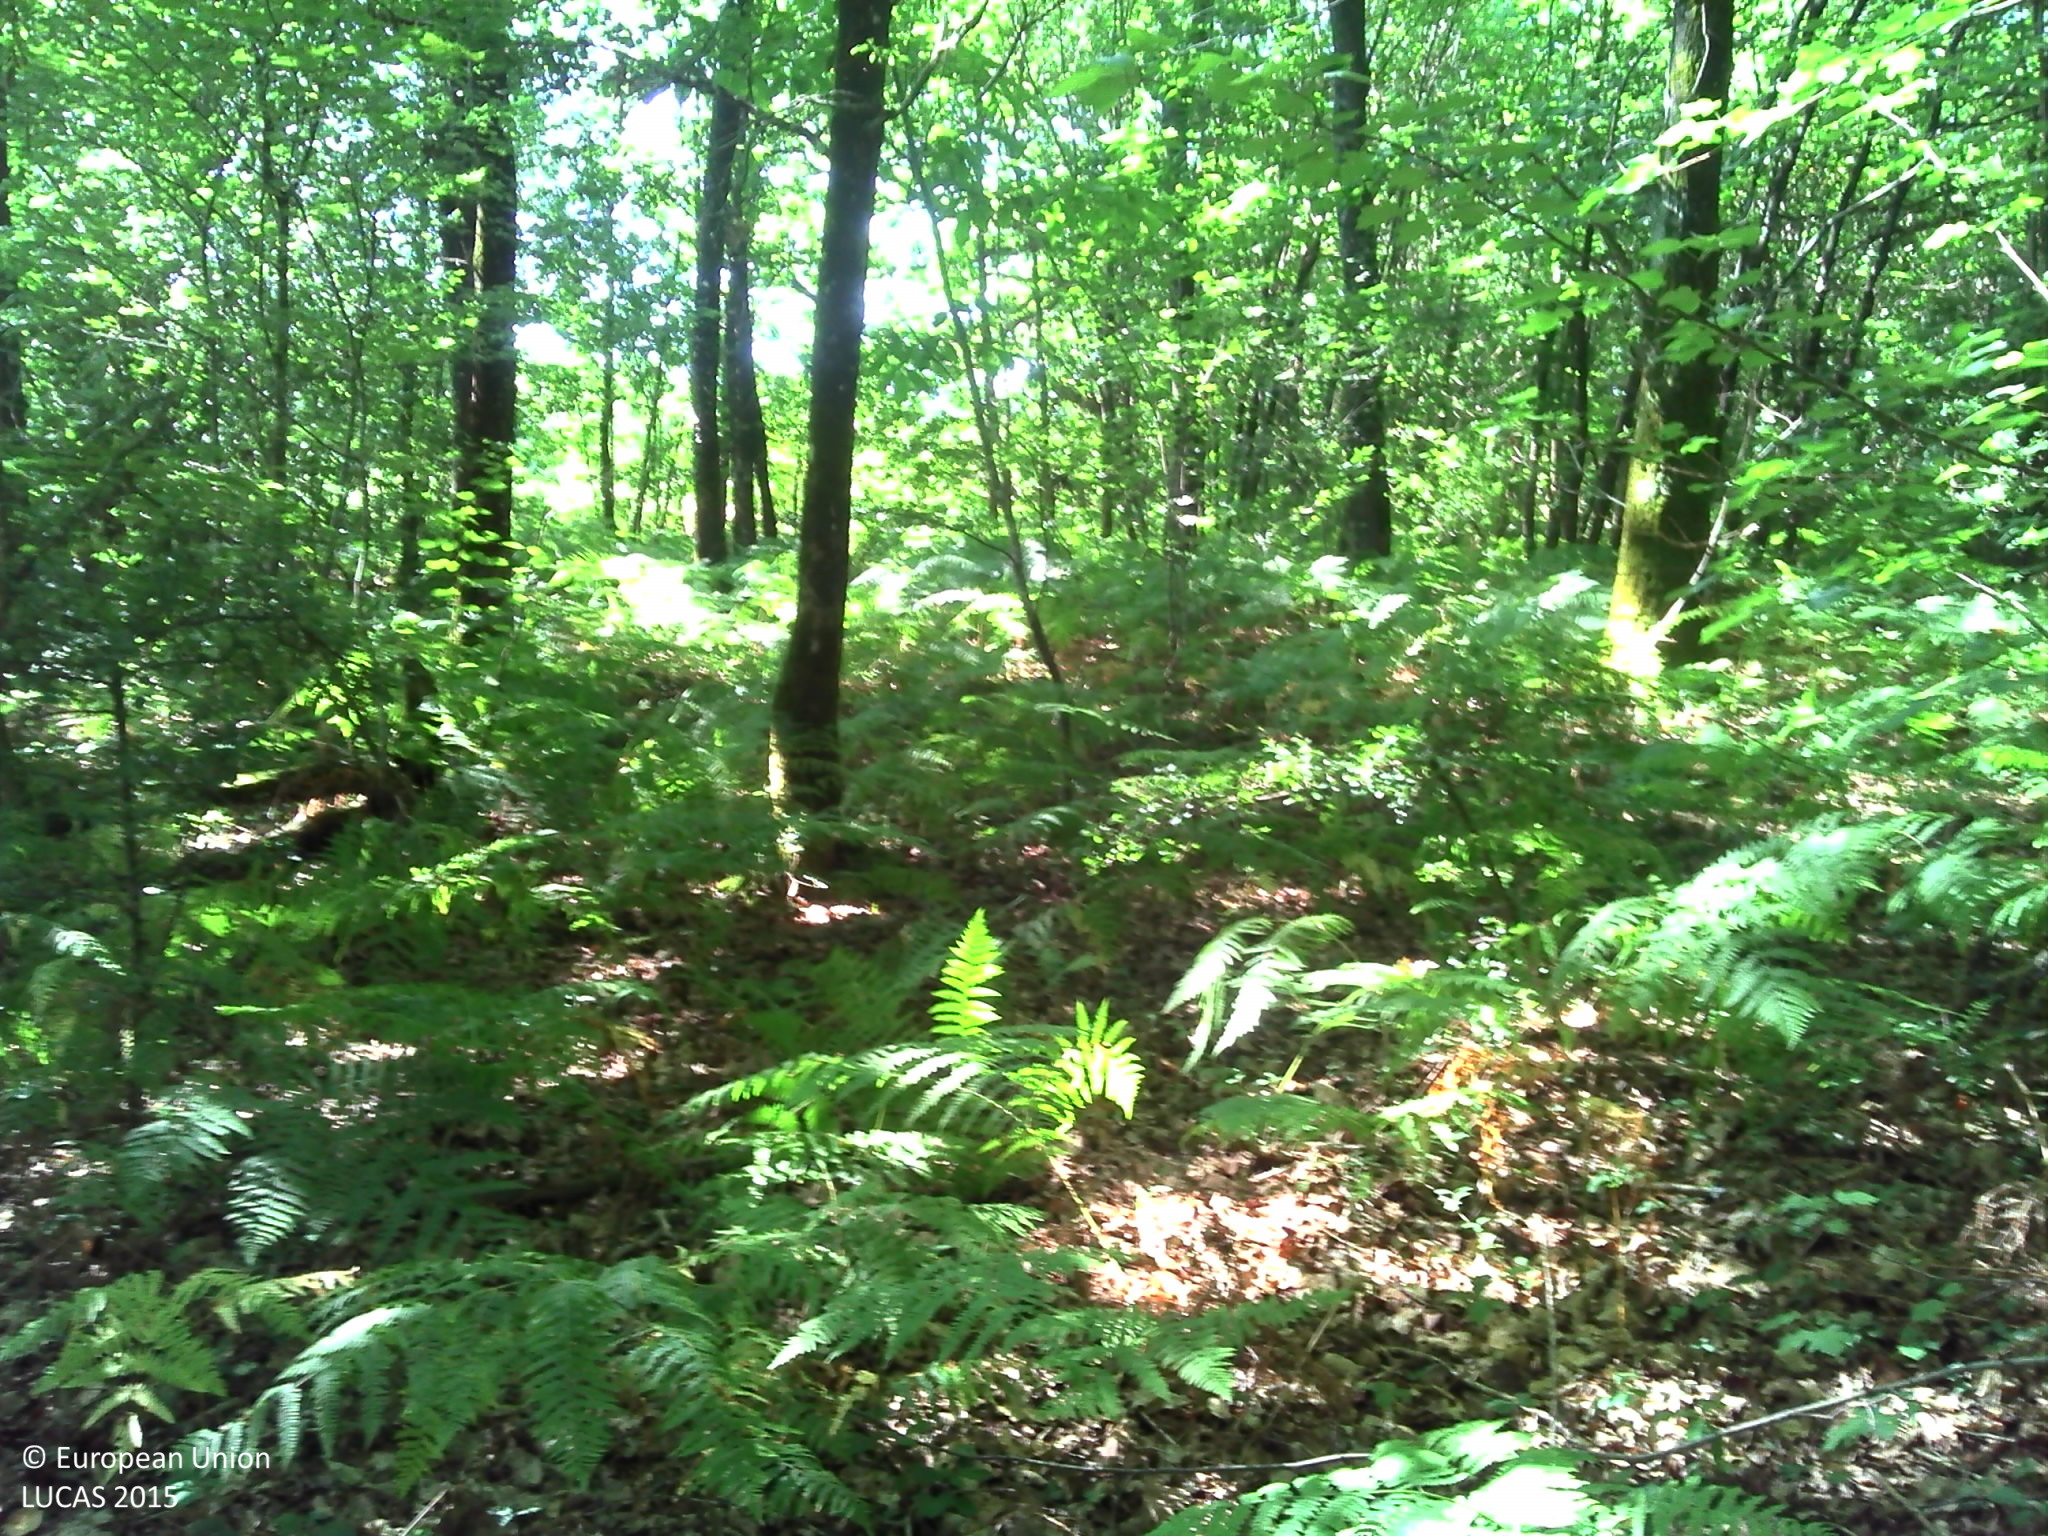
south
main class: Woodland
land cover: Broadleaved woodland
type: acidophilous oak and oak-birch forest
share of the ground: > 75 %
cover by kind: broadleaved forest trees 80 %, herbaceous plants 20 %
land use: Forestry
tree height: > 5 m
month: July
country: FR
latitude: 47.7633
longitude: -2.0188
